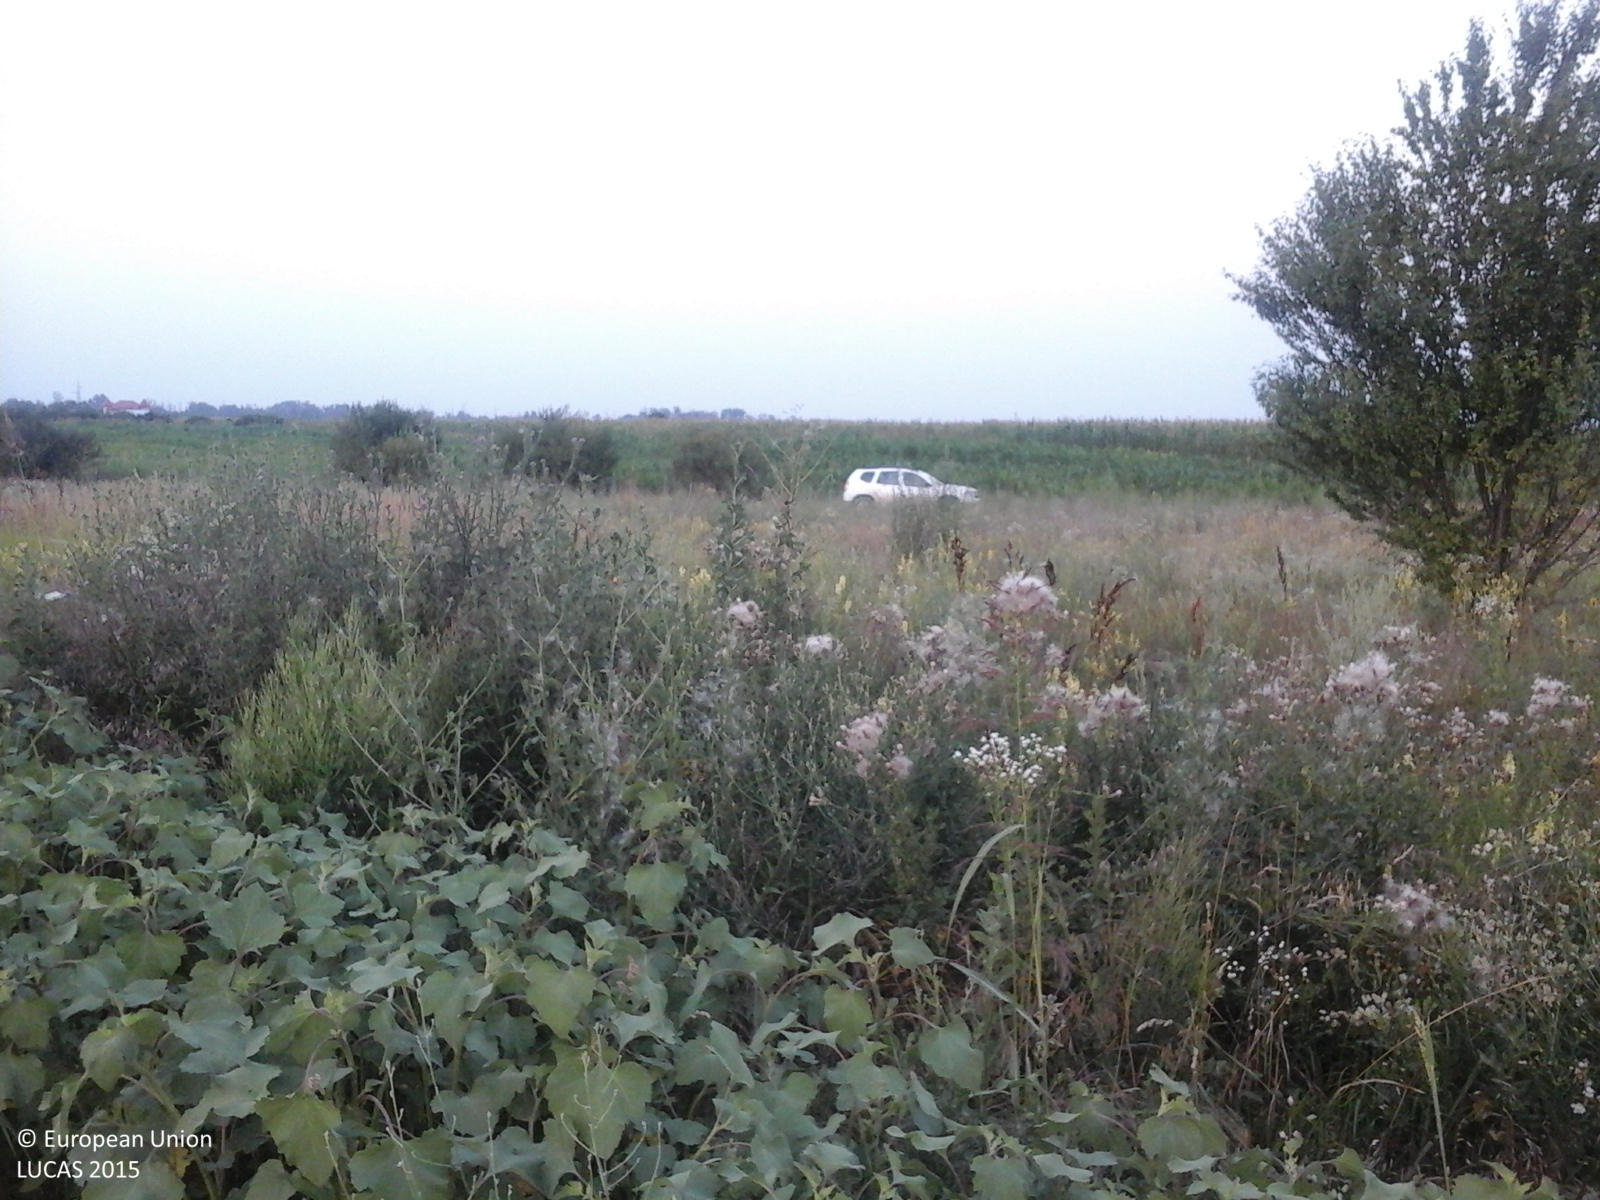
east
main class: Cropland
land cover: Other fresh vegetables
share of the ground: 50 - 75 %
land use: Agriculture (excluding fallow land and kitchen gardens)
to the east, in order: Other fresh vegetables; Spontaneously vegetated surfaces
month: July
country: RO
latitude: 44.5508
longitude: 25.5128
